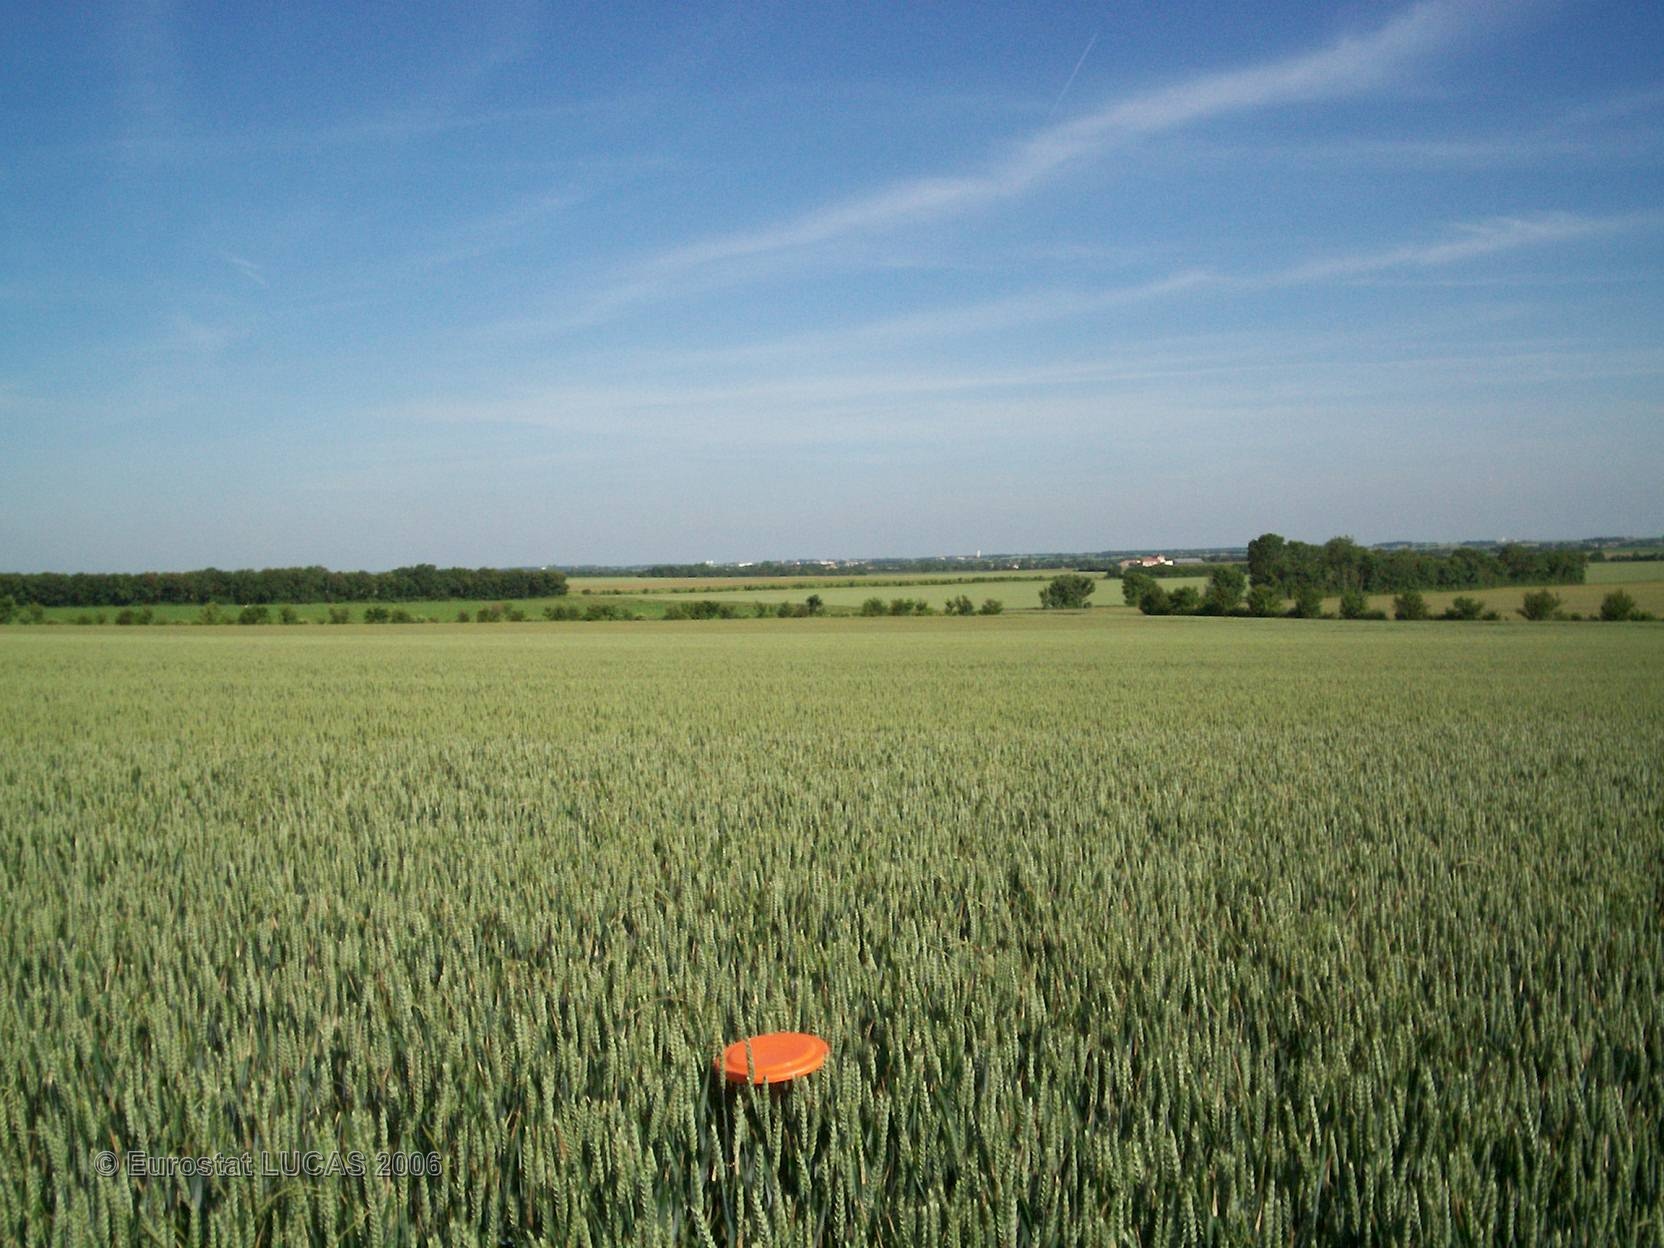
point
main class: Cropland
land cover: Common wheat
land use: Agriculture (excluding fallow land and kitchen gardens)
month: June
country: FR
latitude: 46.0680
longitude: -0.6922
